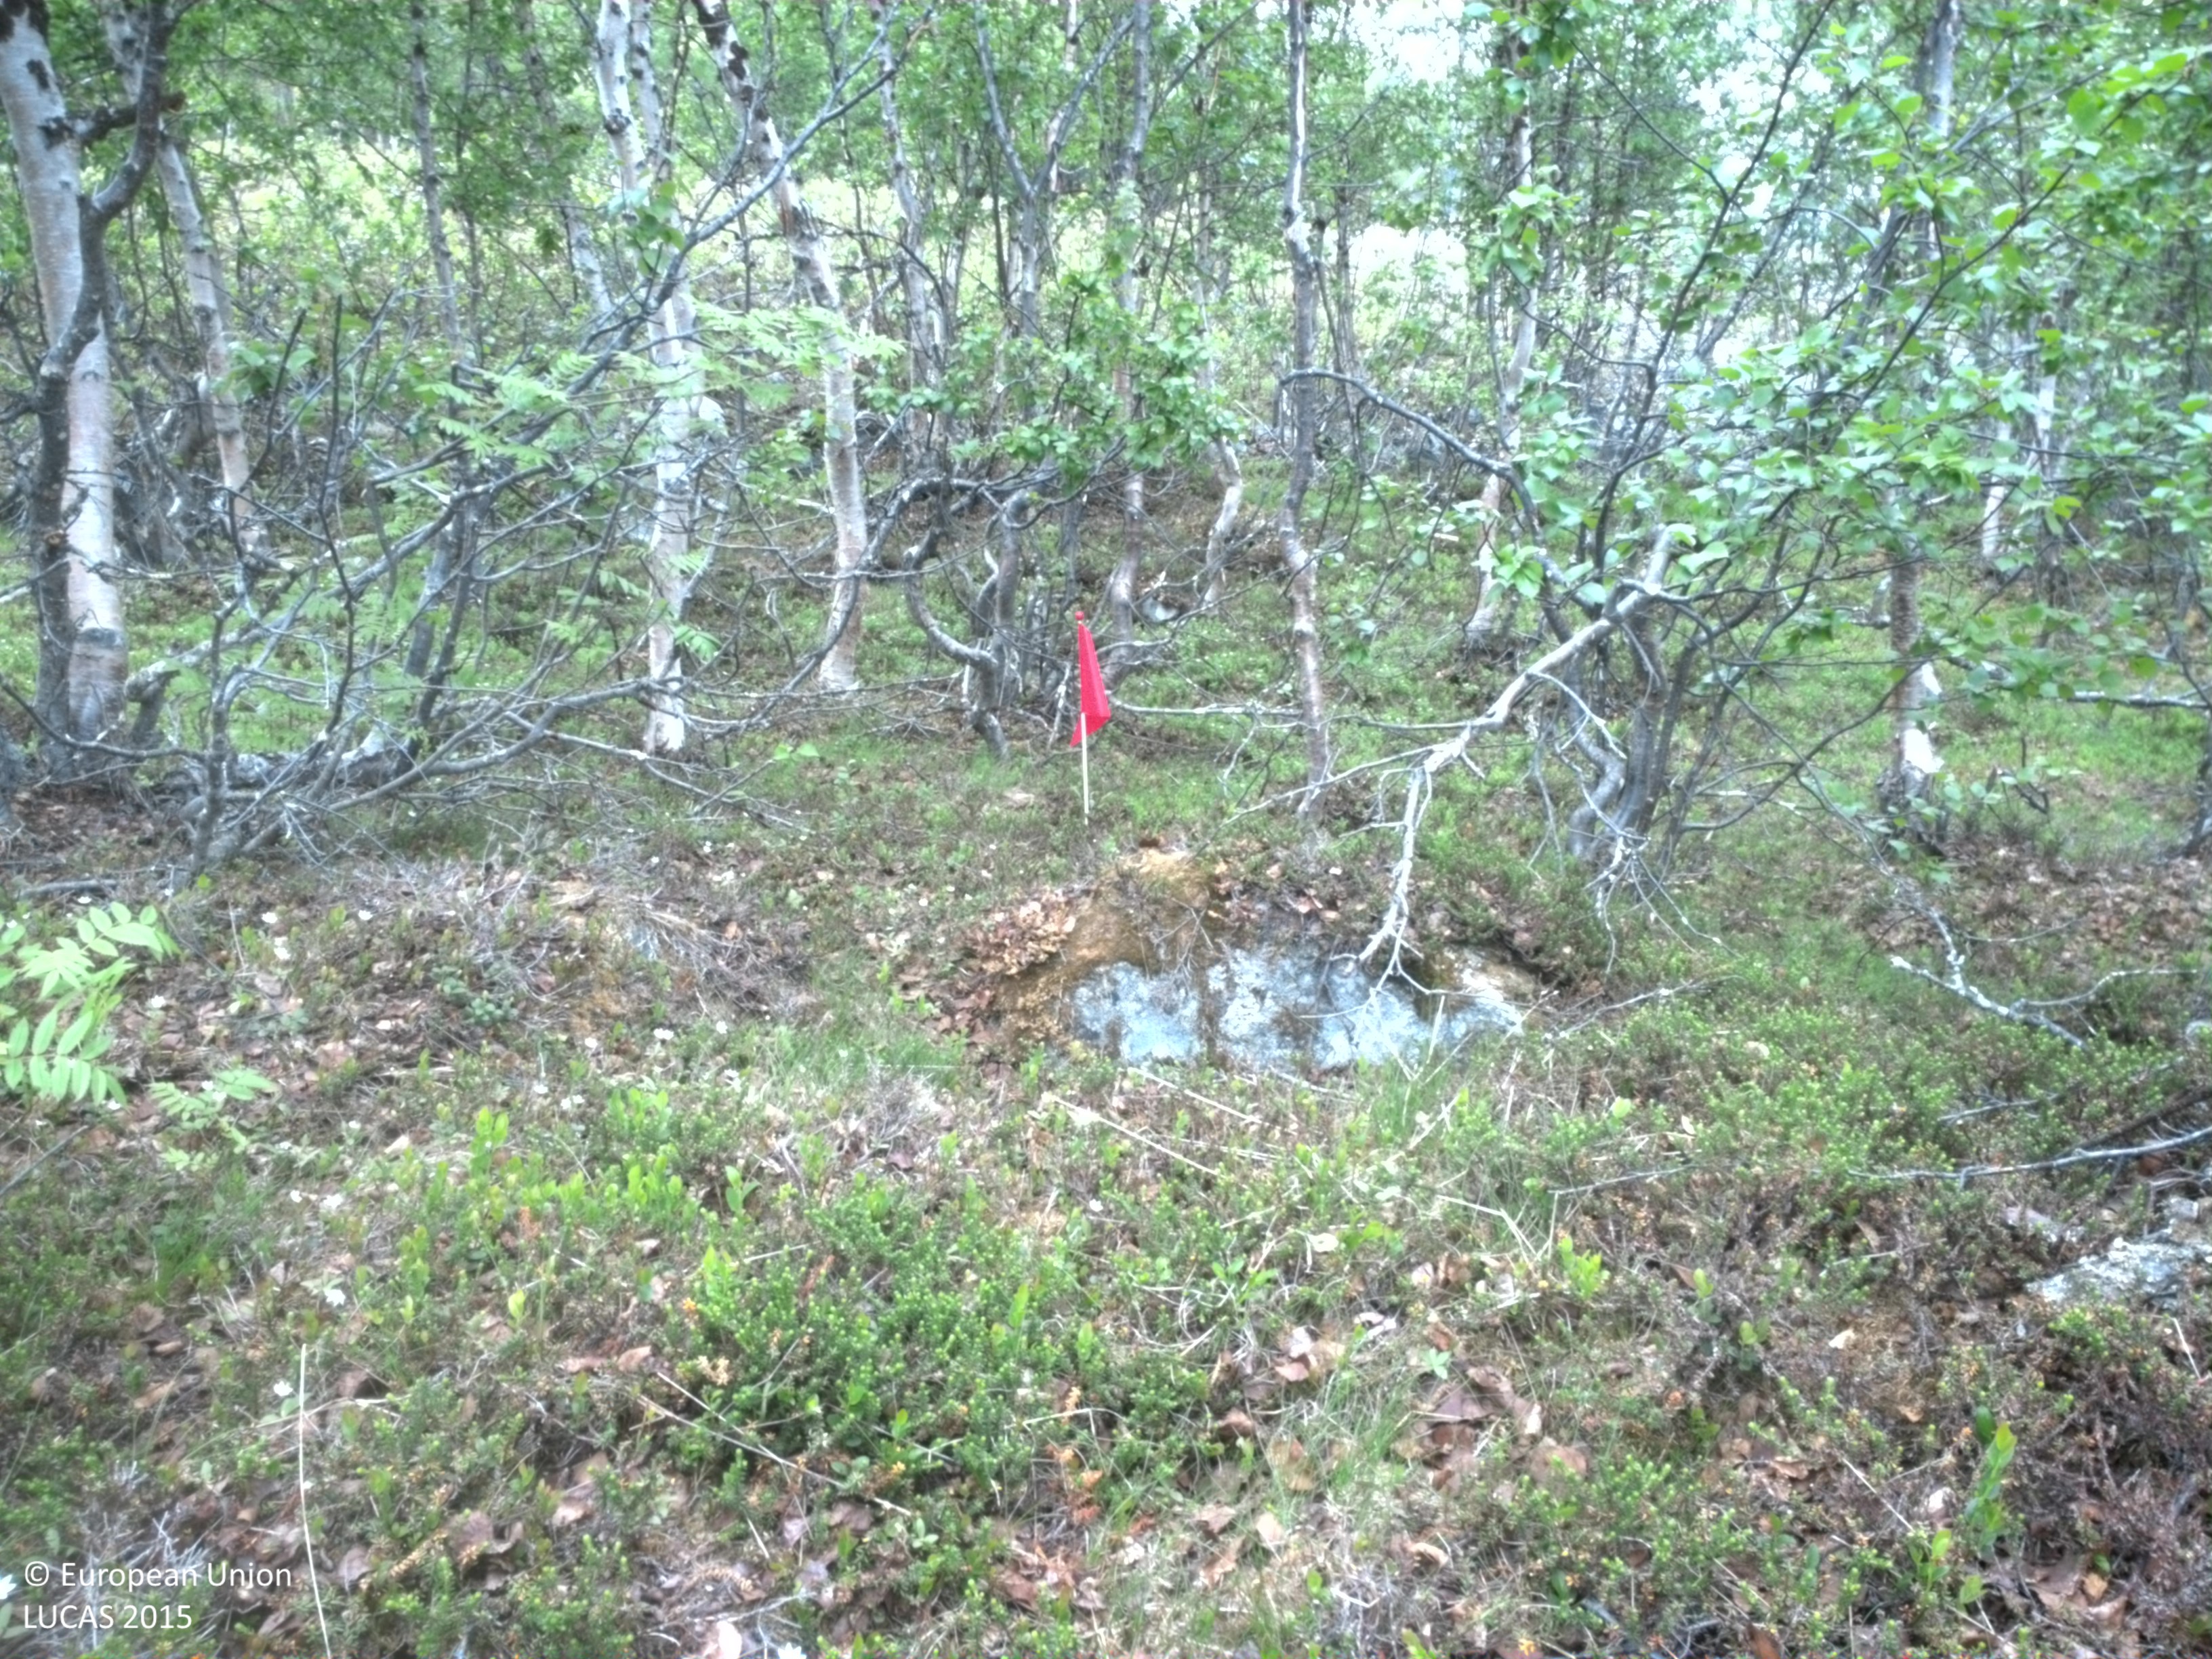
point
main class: Woodland
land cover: Broadleaved woodland
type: non-riverine alder, birch or aspen forest
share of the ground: 50 - 75 %
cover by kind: broadleaved forest trees 60 %, shrubs 35 %, lichens and mosses 5 %
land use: Amenities, museums, leisure
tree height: < 5 m
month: July
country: SE
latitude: 67.7305
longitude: 17.4843
